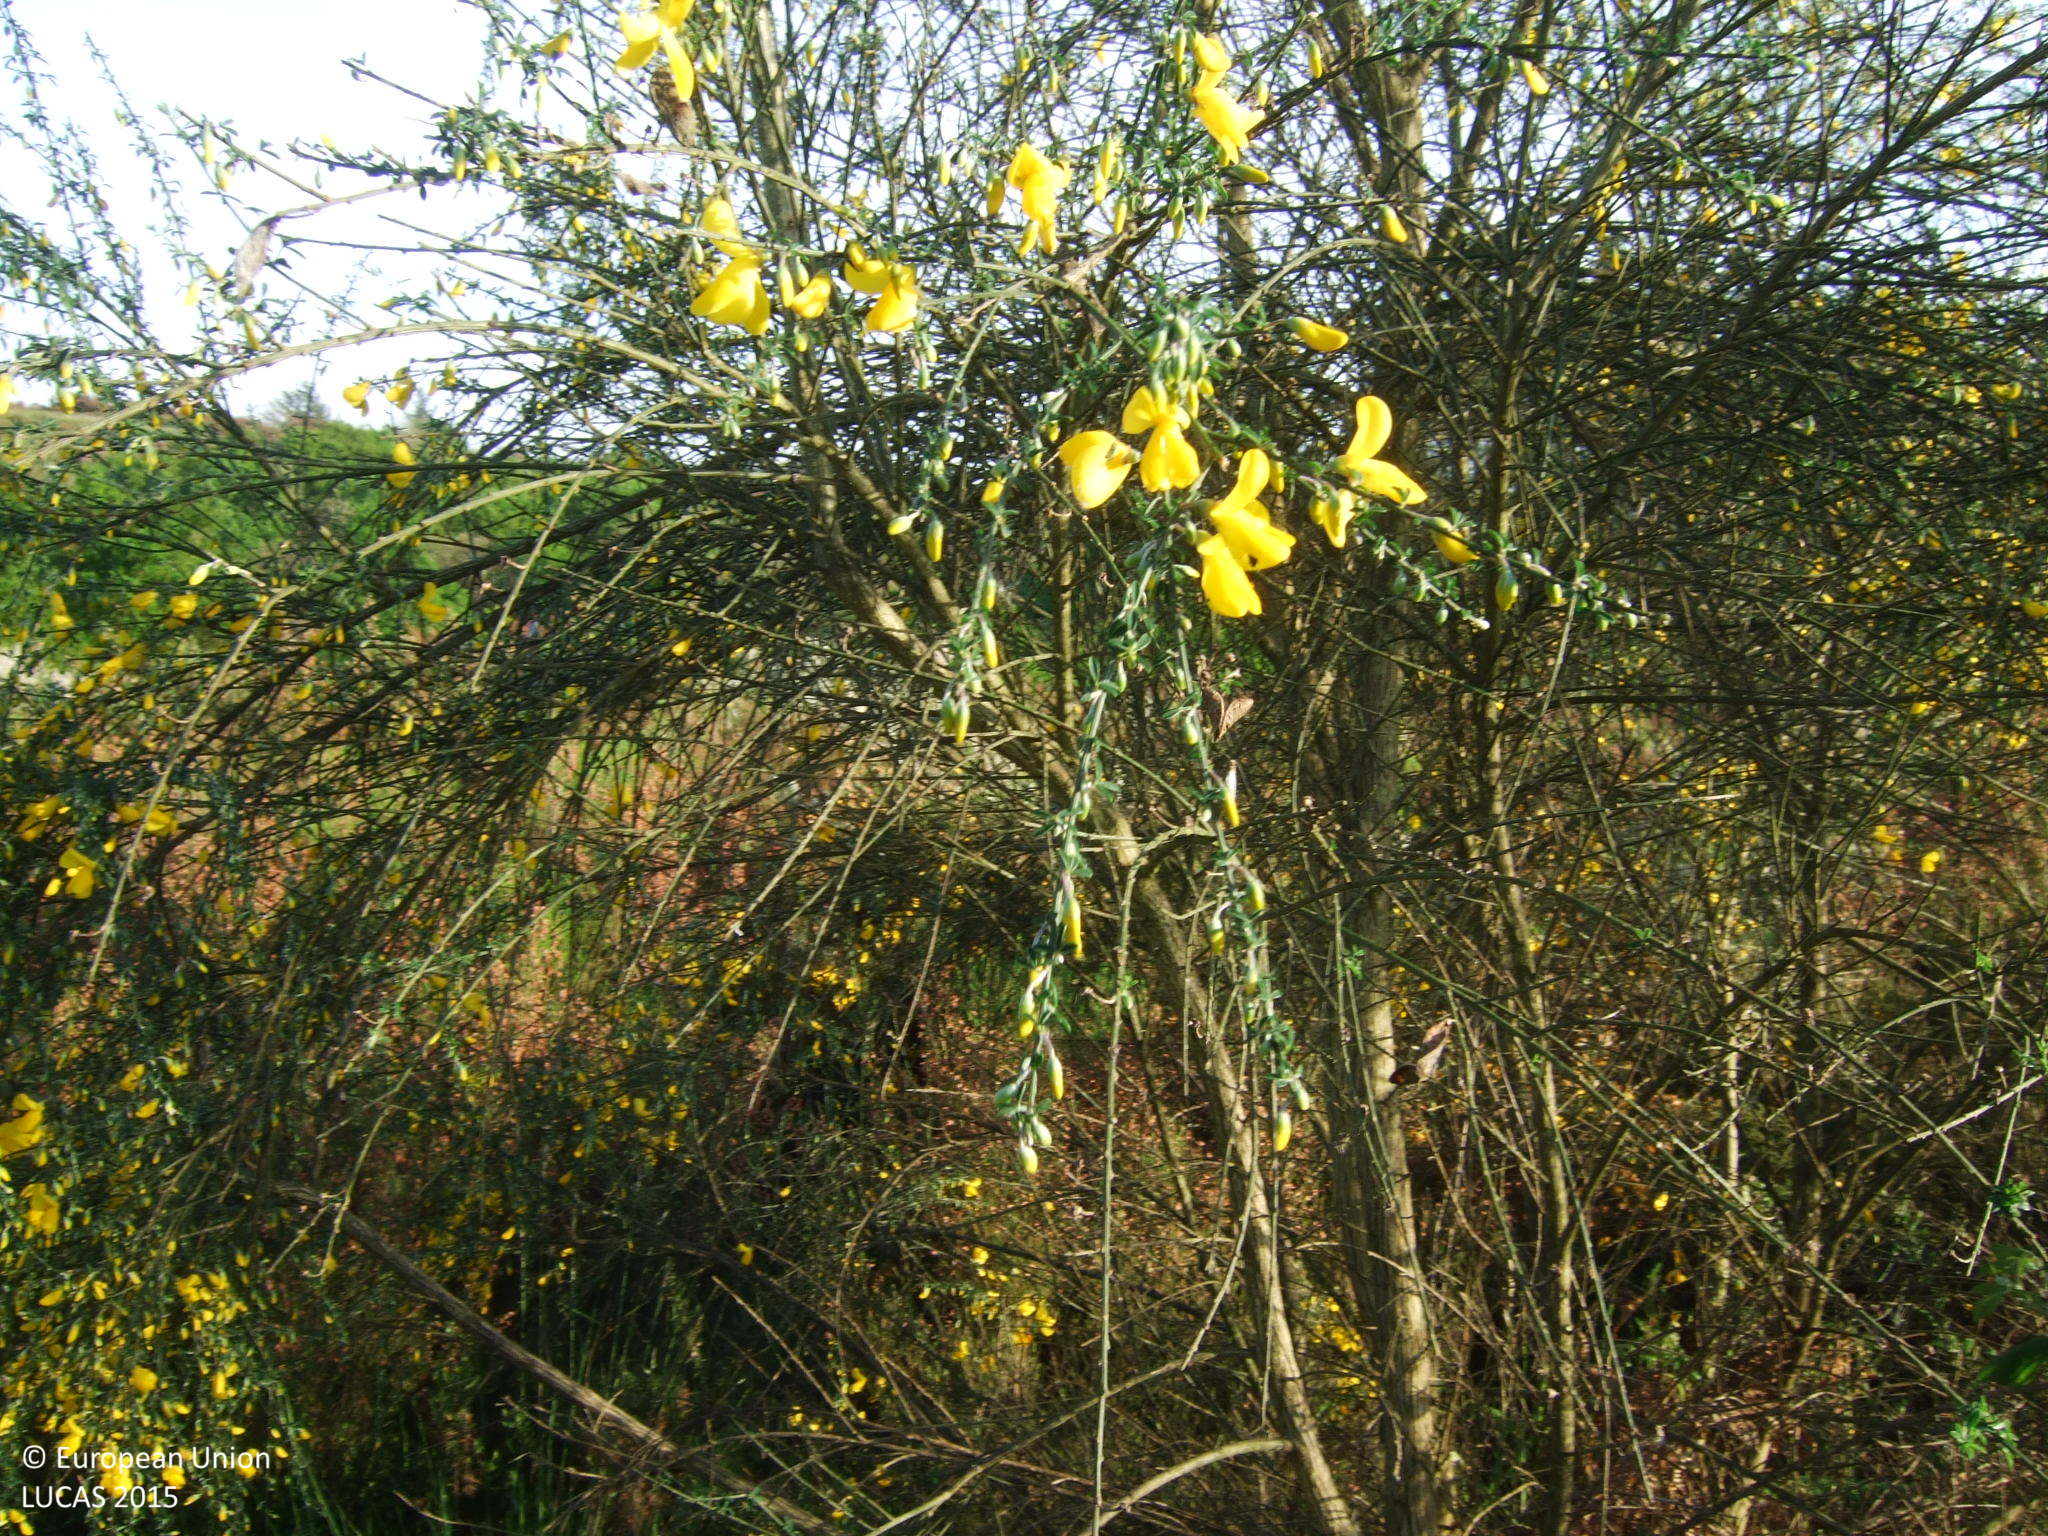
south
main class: Shrubland
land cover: Shrubland without tree cover
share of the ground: > 75 %
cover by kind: shrubs 100 %
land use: Abandoned areas
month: May
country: ES
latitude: 43.0432
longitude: -7.4441
